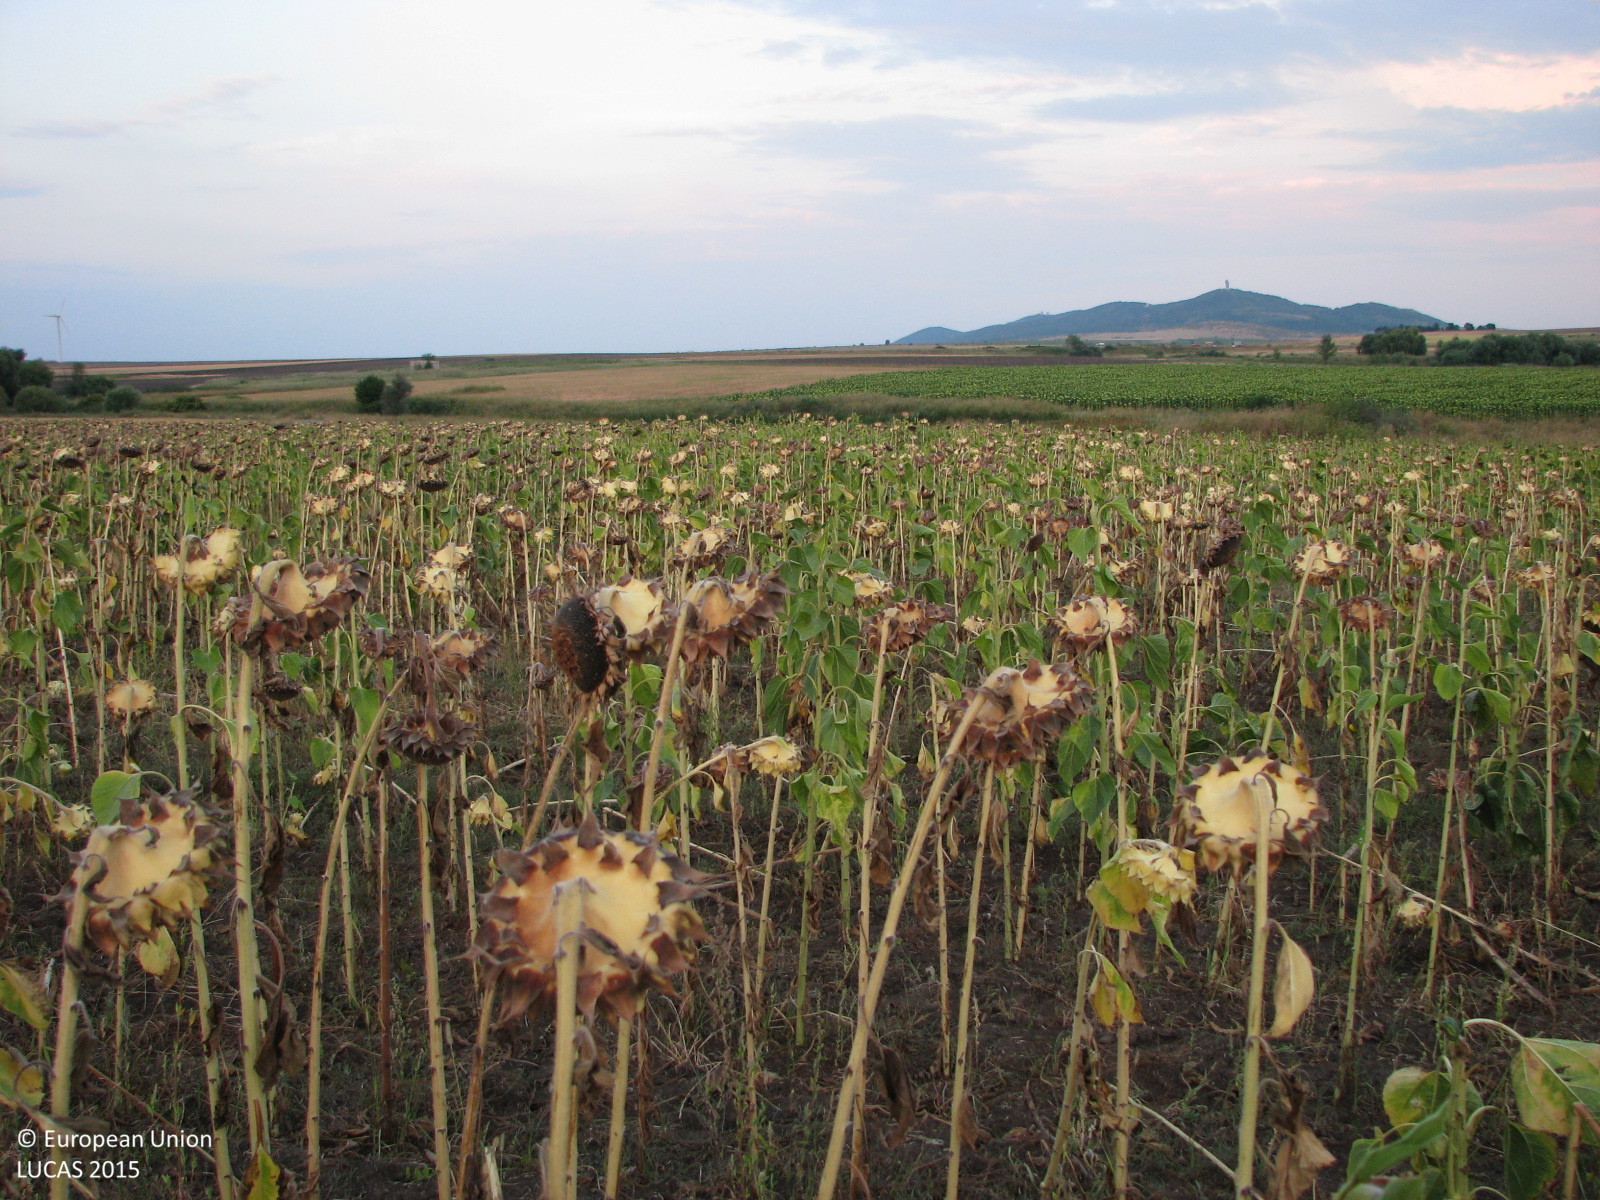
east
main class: Cropland
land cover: Sunflower
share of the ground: > 75 %
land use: Agriculture (excluding fallow land and kitchen gardens)
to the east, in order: Sunflower; Common wheat; Grass margins; Tracks; Spontaneously vegetated surfaces; Ditches and canals
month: August
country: BG
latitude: 42.4730
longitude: 26.5750
